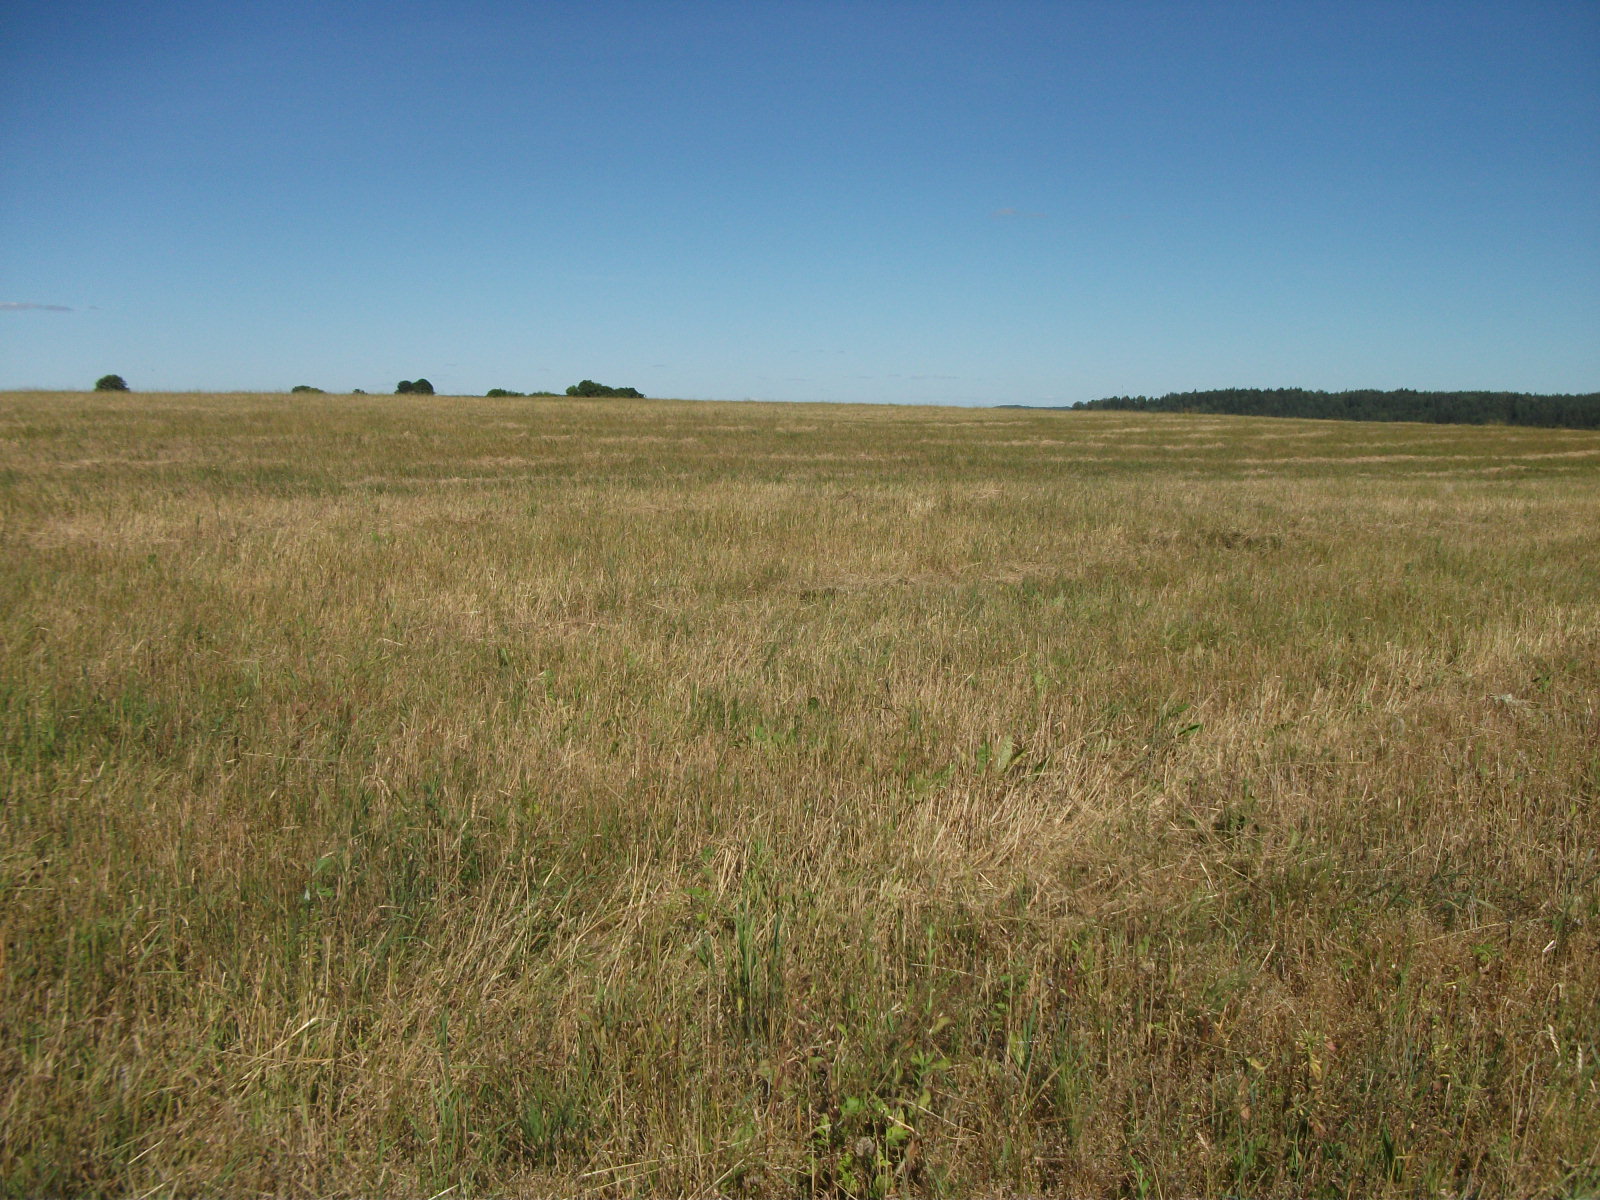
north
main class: Grassland
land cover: Grassland without tree/shrub cover
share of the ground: > 75 %
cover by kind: herbaceous plants 100 %
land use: Agriculture (excluding fallow land and kitchen gardens)
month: August
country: LV
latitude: 56.6807
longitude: 26.1498
